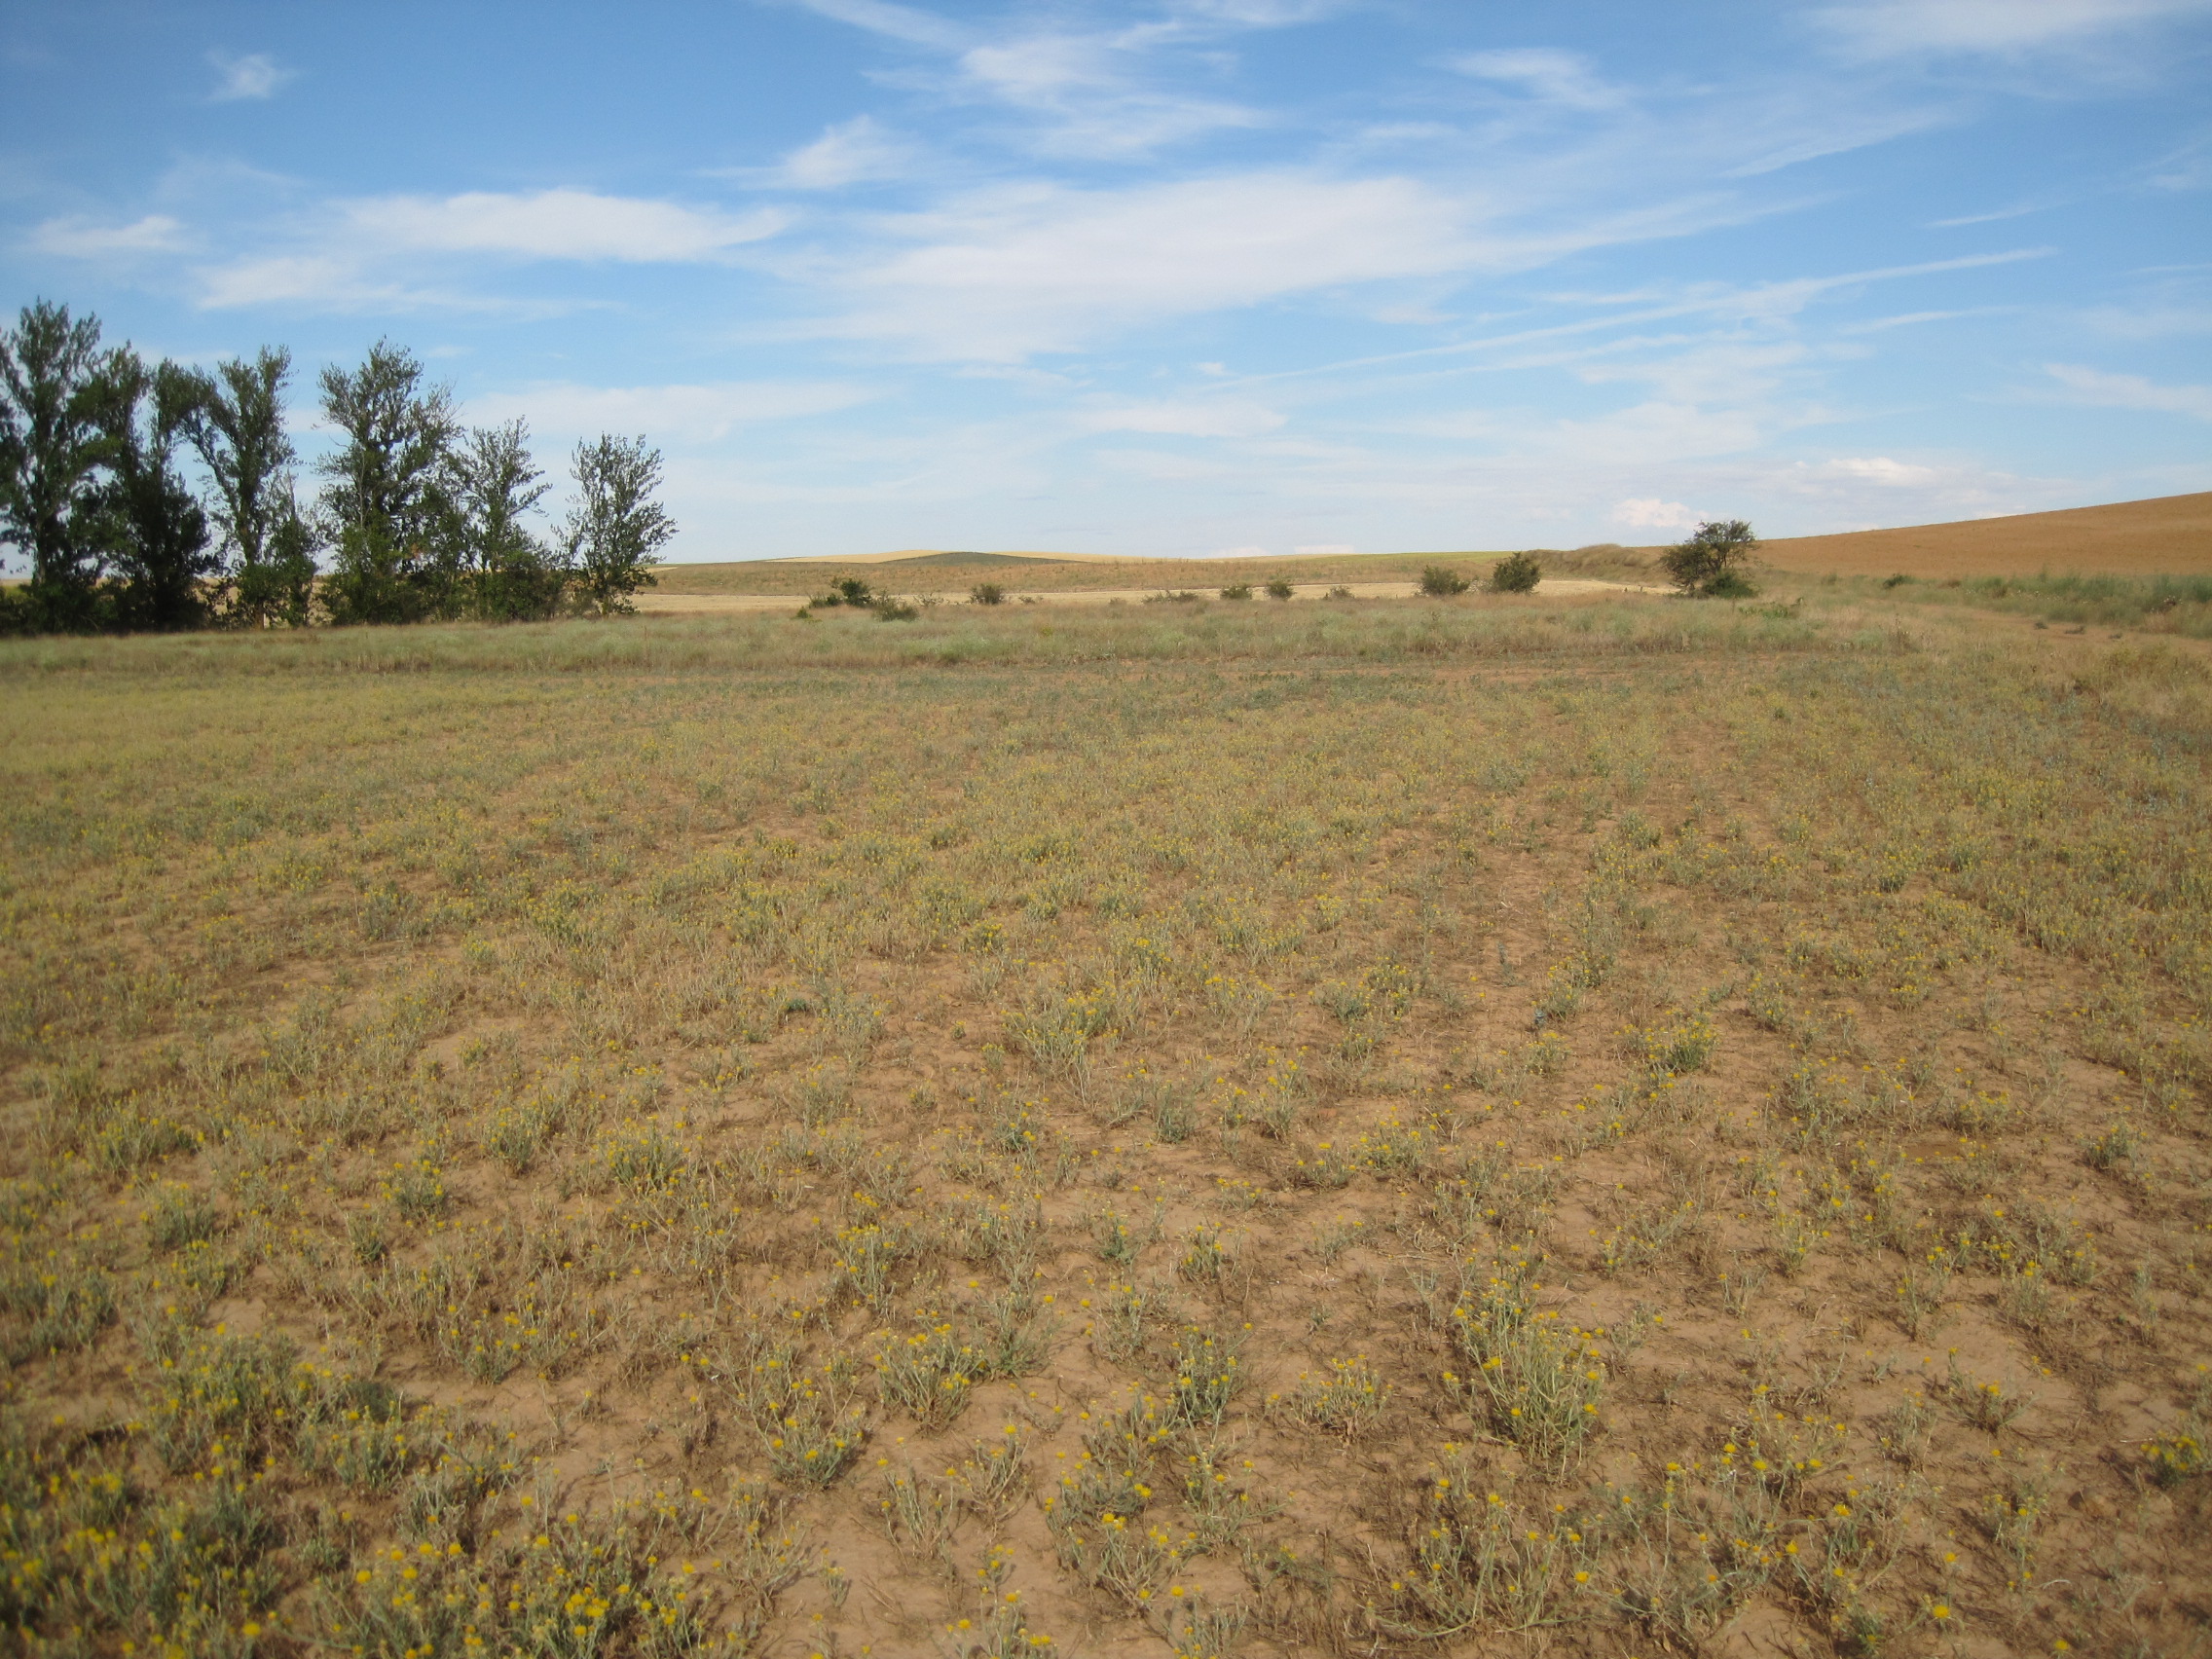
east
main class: Cropland
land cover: Dry pulses
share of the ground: < 10 %
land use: Agriculture (excluding fallow land and kitchen gardens)
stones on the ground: < 10 %
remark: Harvested field
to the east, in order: Dry pulses; Spontaneously vegetated surfaces; Grassland with sparse tree/shrub cover; Barley
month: July
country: ES
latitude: 41.9647
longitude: -5.2745
